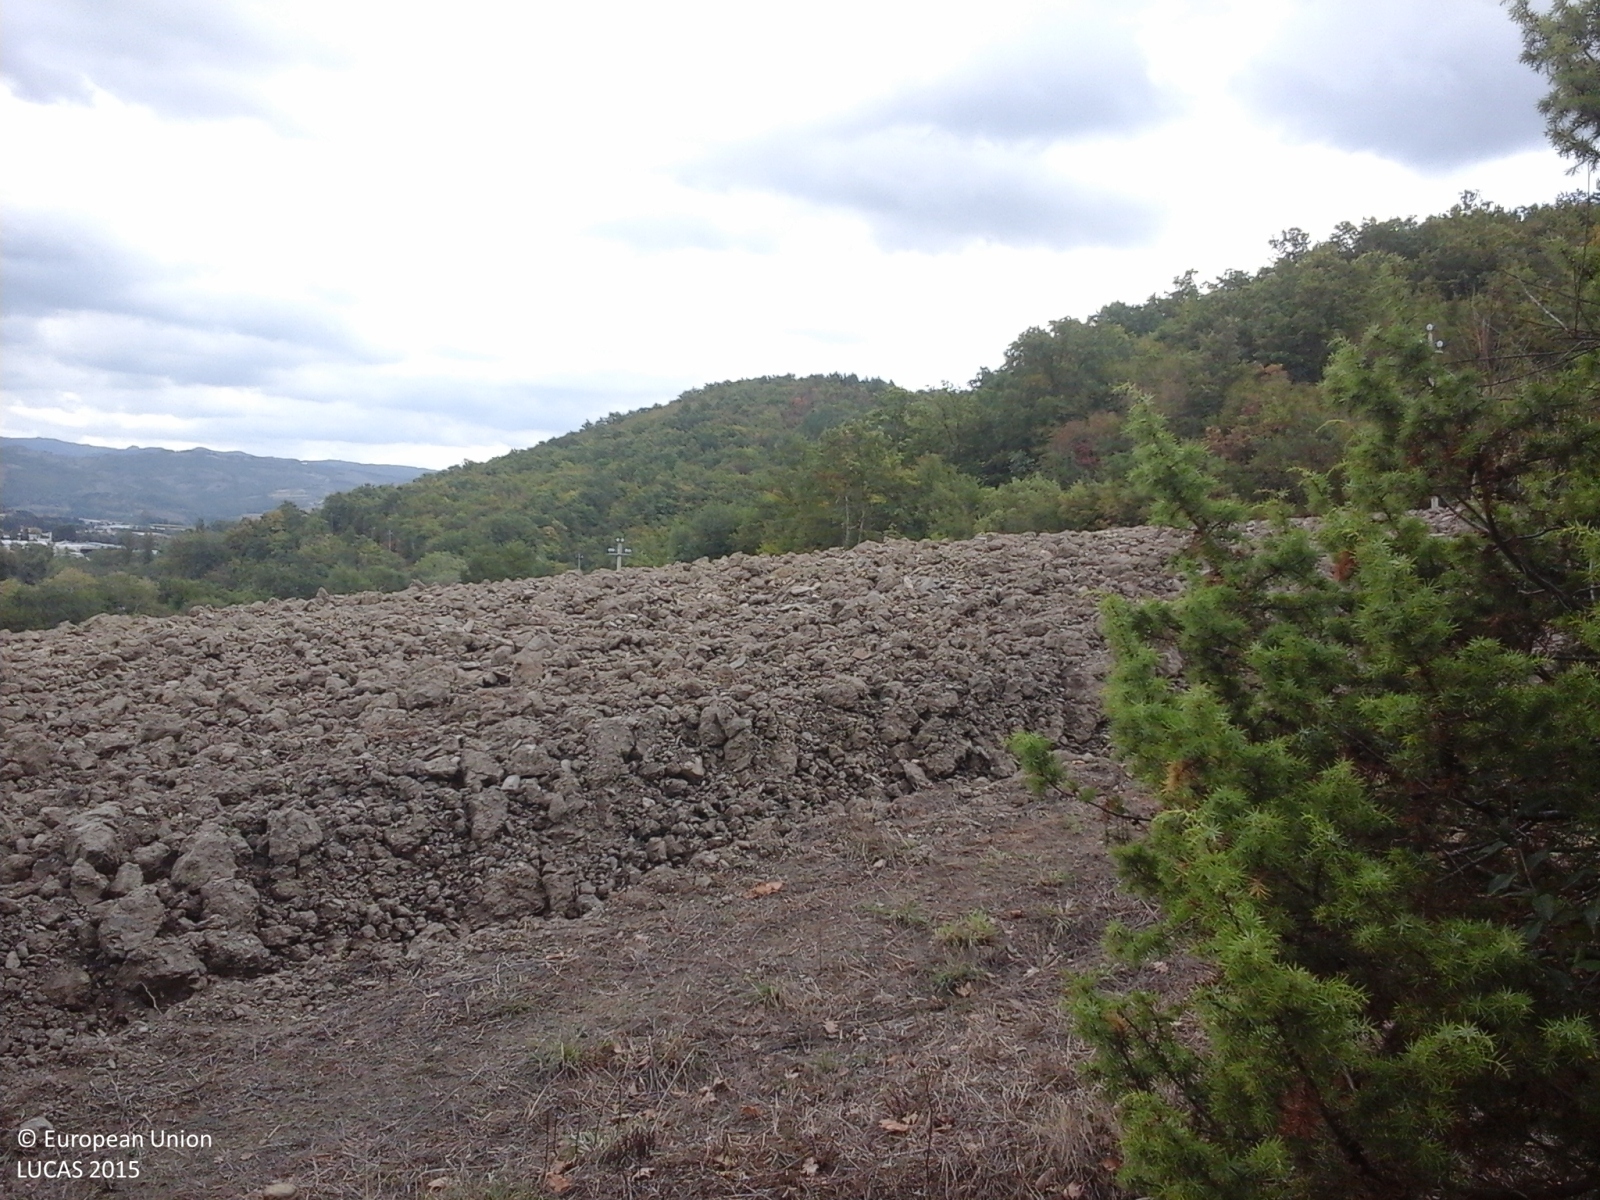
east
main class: Woodland
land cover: Pine dominated mixed woodland
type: coniferous forest of the mediterranean region
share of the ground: > 75 %
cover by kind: coniferous forest trees 50 %, broadleaved forest trees 35 %, shrubs 15 %
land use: Forestry
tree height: > 5 m
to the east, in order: Pine dominated mixed woodland; Tracks; Other bare soil
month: October
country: IT
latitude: 43.2957
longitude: 12.3231
